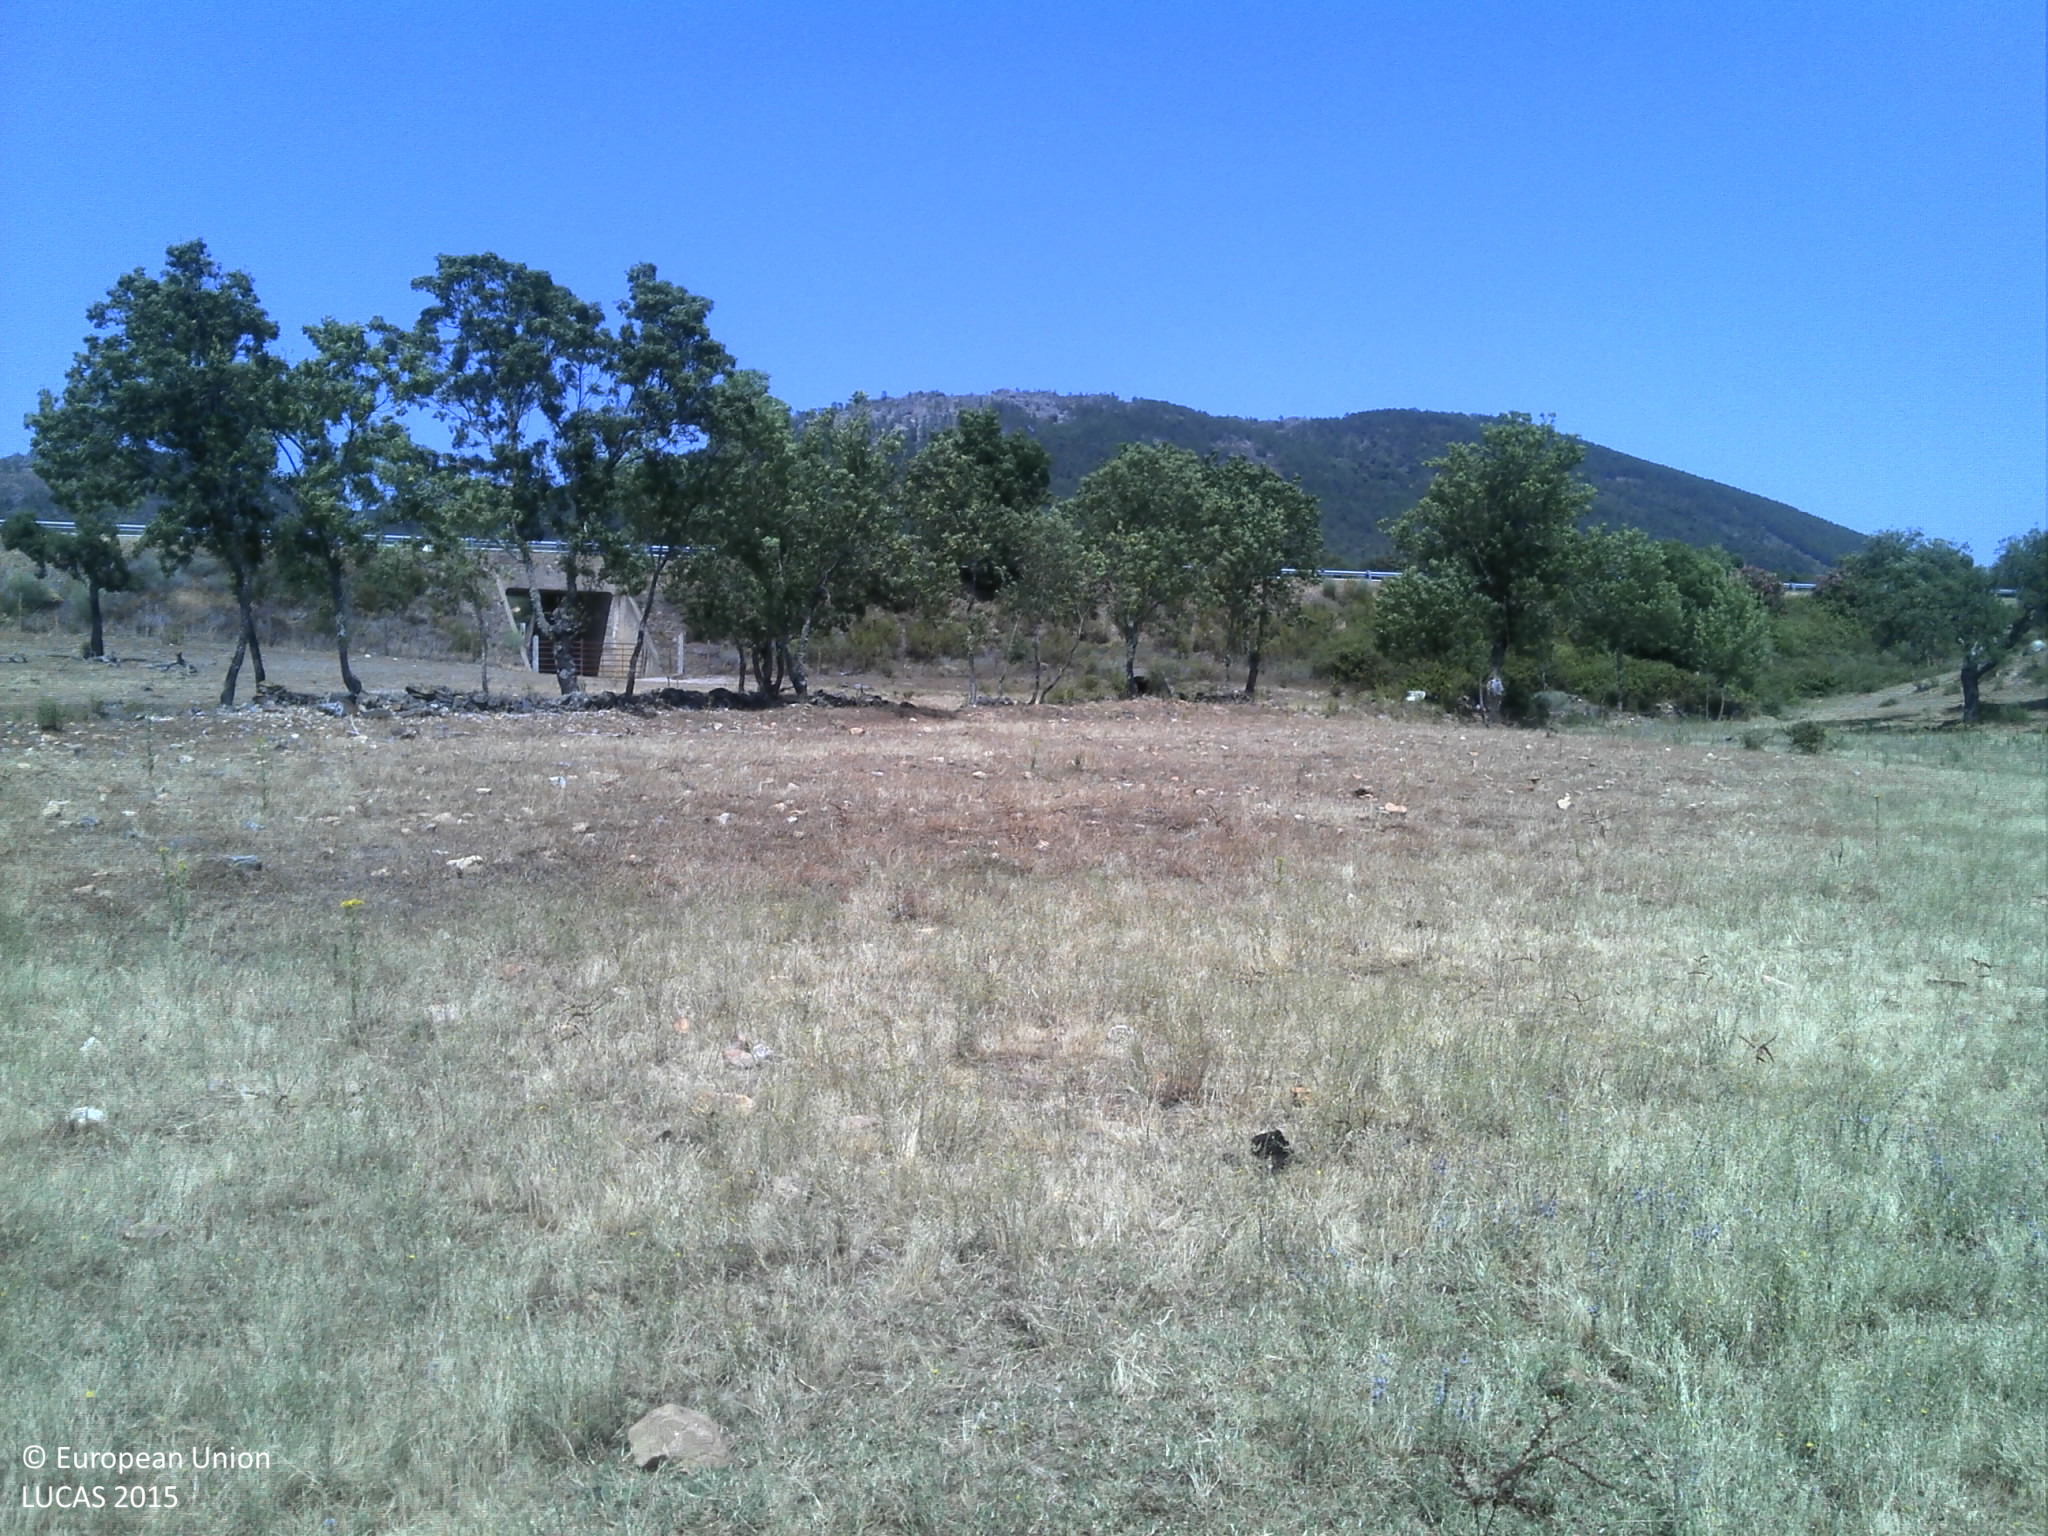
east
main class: Grassland
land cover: Grassland without tree/shrub cover
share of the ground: 50 - 75 %
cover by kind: herbaceous plants 65 %, unconsolidated bare surface 35 %
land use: Agriculture (excluding fallow land and kitchen gardens)
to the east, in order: Grassland without tree/shrub cover; Abandoned hedges; Dry stone walls; Tracks; Shrubland without tree cover; Fences; Abandoned hedges; Grass margins; Paved roads, cycling and walking lanes; Shrubland with sparse tree cover; Fences; Grassland without tree/shrub cover
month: June
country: PT
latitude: 40.0254
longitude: -6.9994
